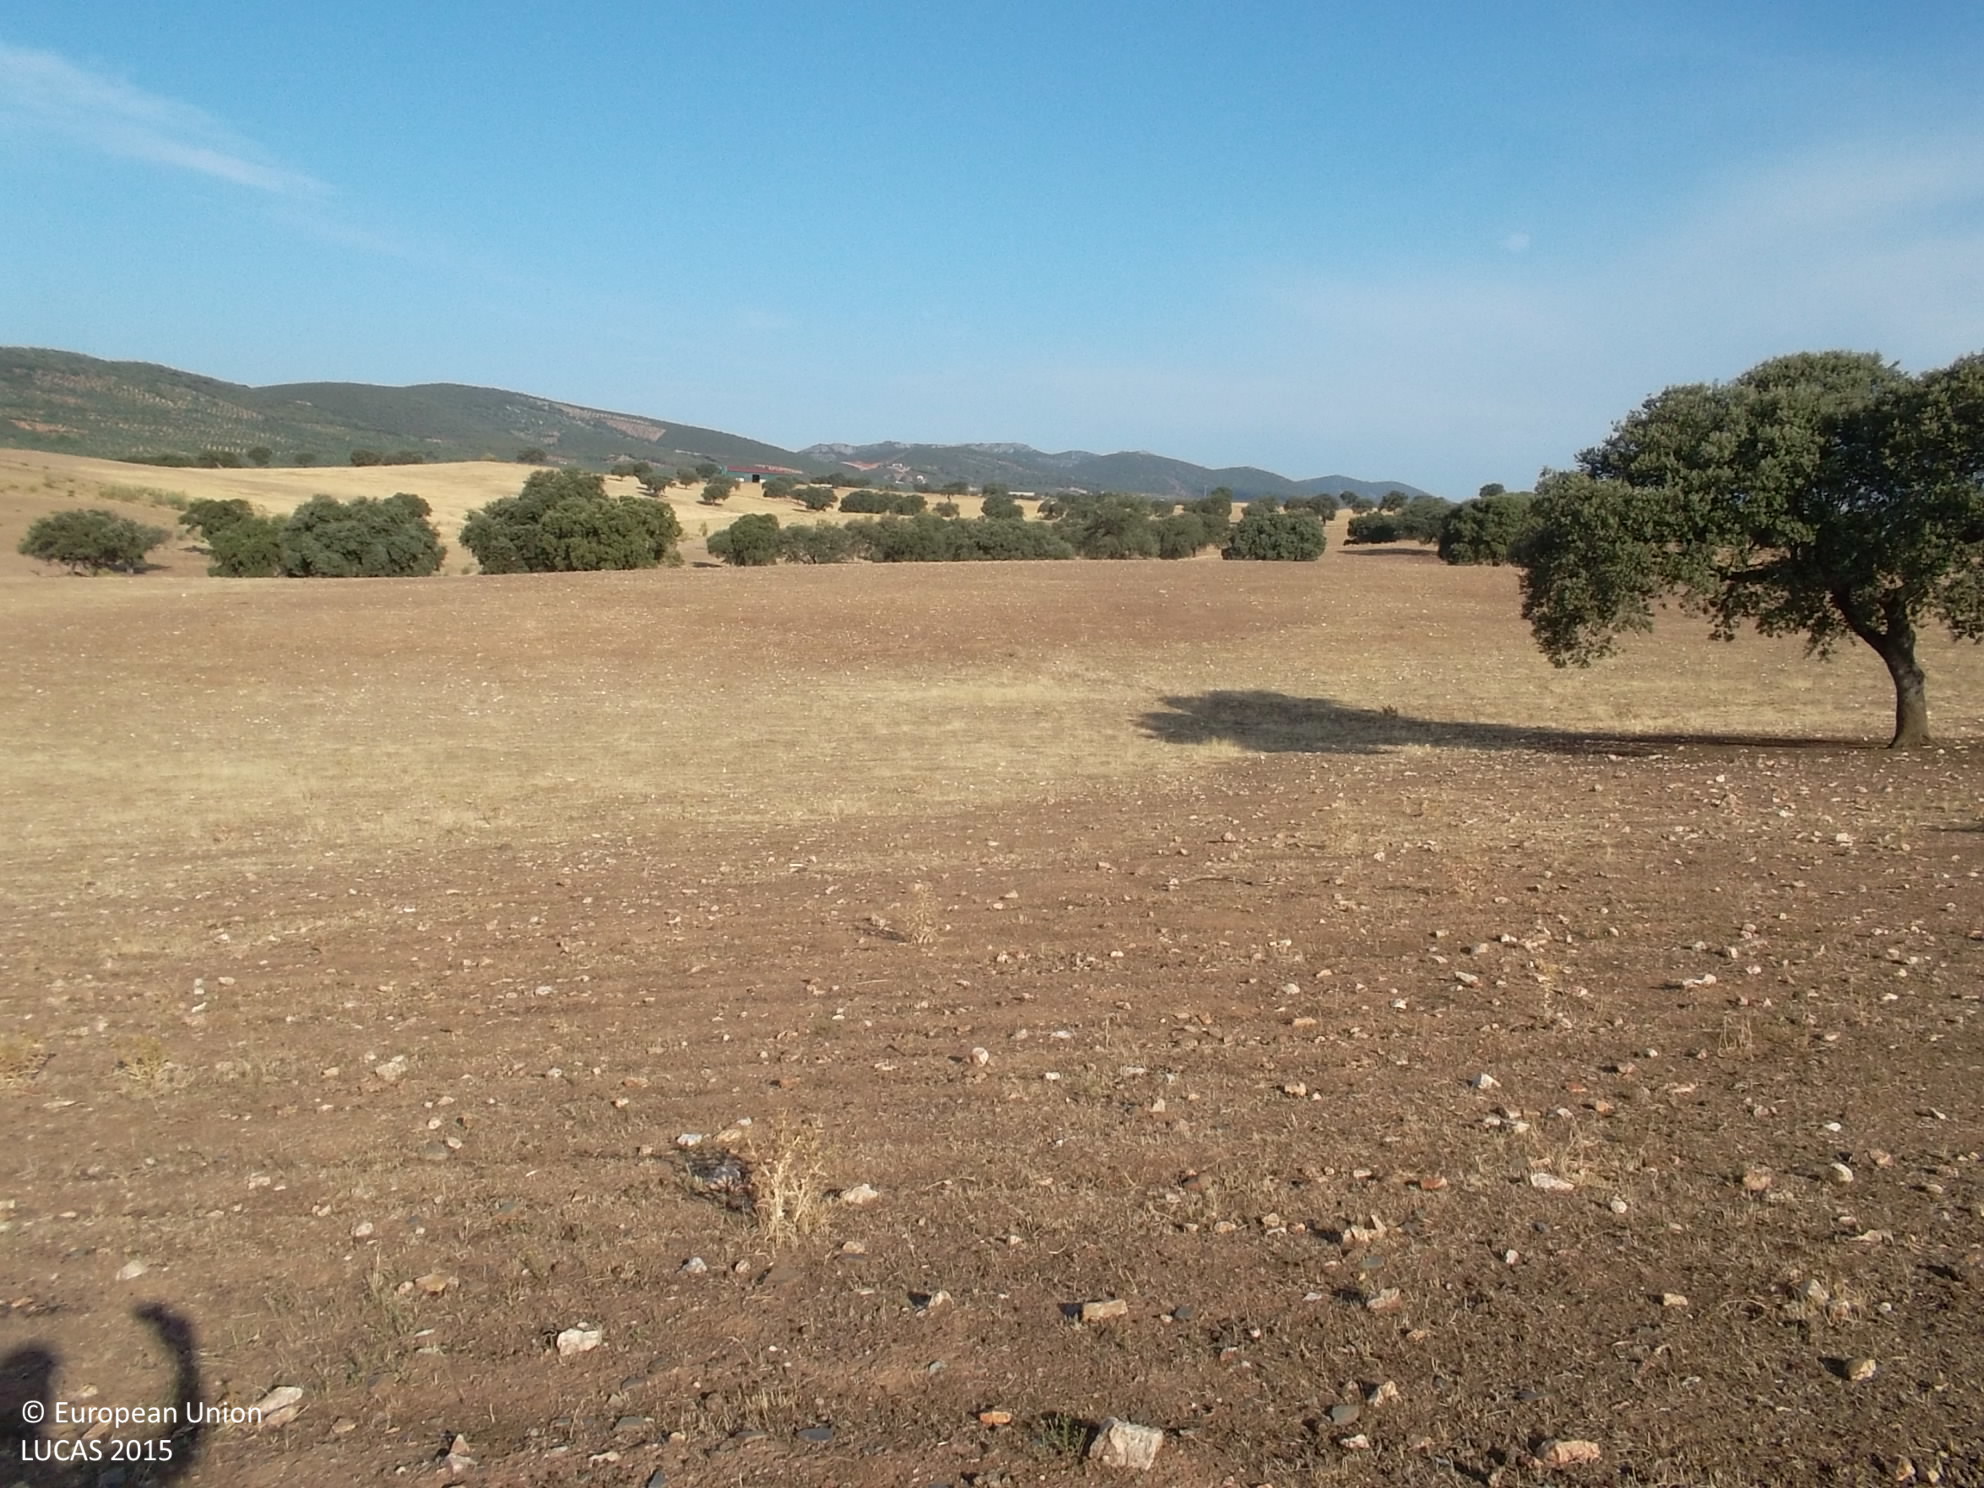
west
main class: Grassland
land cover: Grassland with sparse tree/shrub cover
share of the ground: > 75 %
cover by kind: herbaceous plants 95 %, broadleaved forest trees 5 %
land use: Agriculture (excluding fallow land and kitchen gardens)
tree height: > 5 m
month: July
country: ES
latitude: 38.5648
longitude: -5.4022
